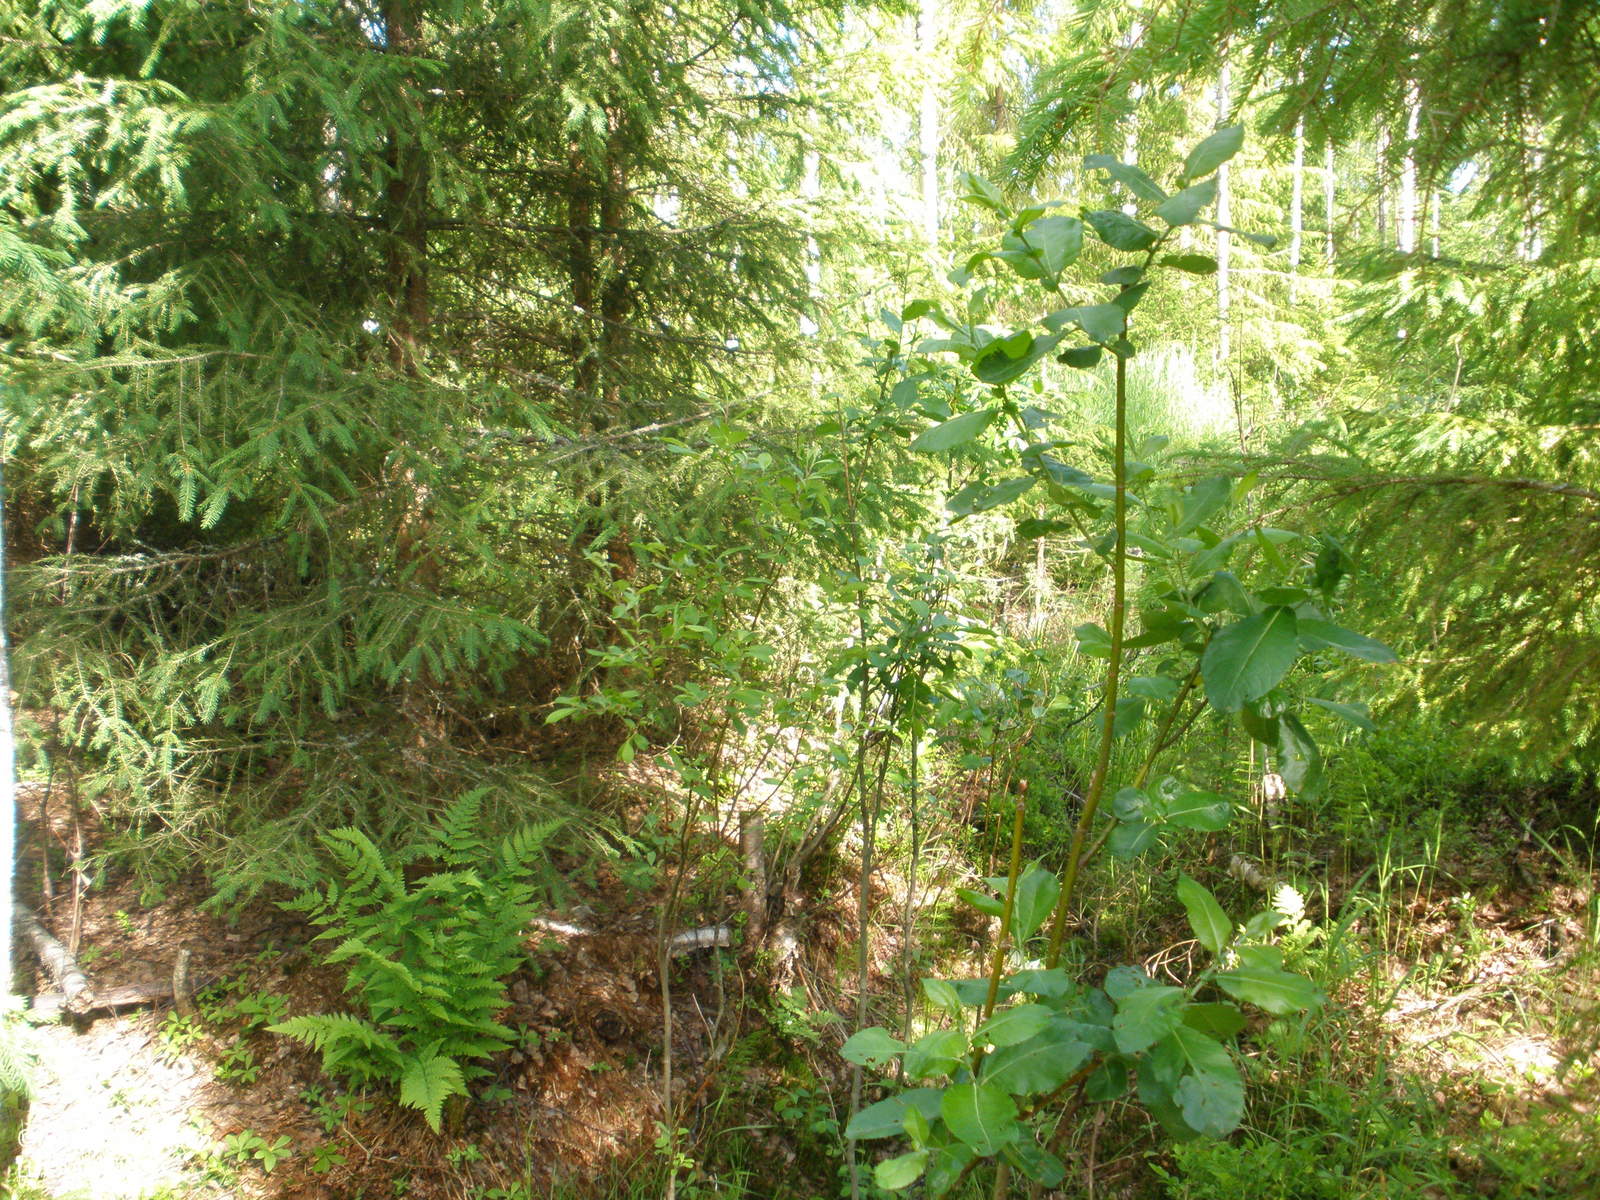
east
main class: Woodland
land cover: Spruce dominated mixed woodland
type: boreal forest
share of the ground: > 75 %
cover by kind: coniferous forest trees 55 %, broadleaved forest trees 25 %, shrubs 5 %, herbaceous plants 5 %, lichens and mosses 5 %
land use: Forestry
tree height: > 5 m
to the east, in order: Spruce dominated mixed woodland; Ditches and canals; Spruce dominated mixed woodland; Ditches and canals; Spruce dominated mixed woodland; Ditches and canals; Spruce dominated mixed woodland; Ditches and canals; Spruce dominated mixed woodland; Ditches and canals; Spruce dominated mixed woodland; Tracks; Ditches and canals; Spruce dominated coniferous woodland
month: June
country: FI
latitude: 61.0979
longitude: 24.6654
